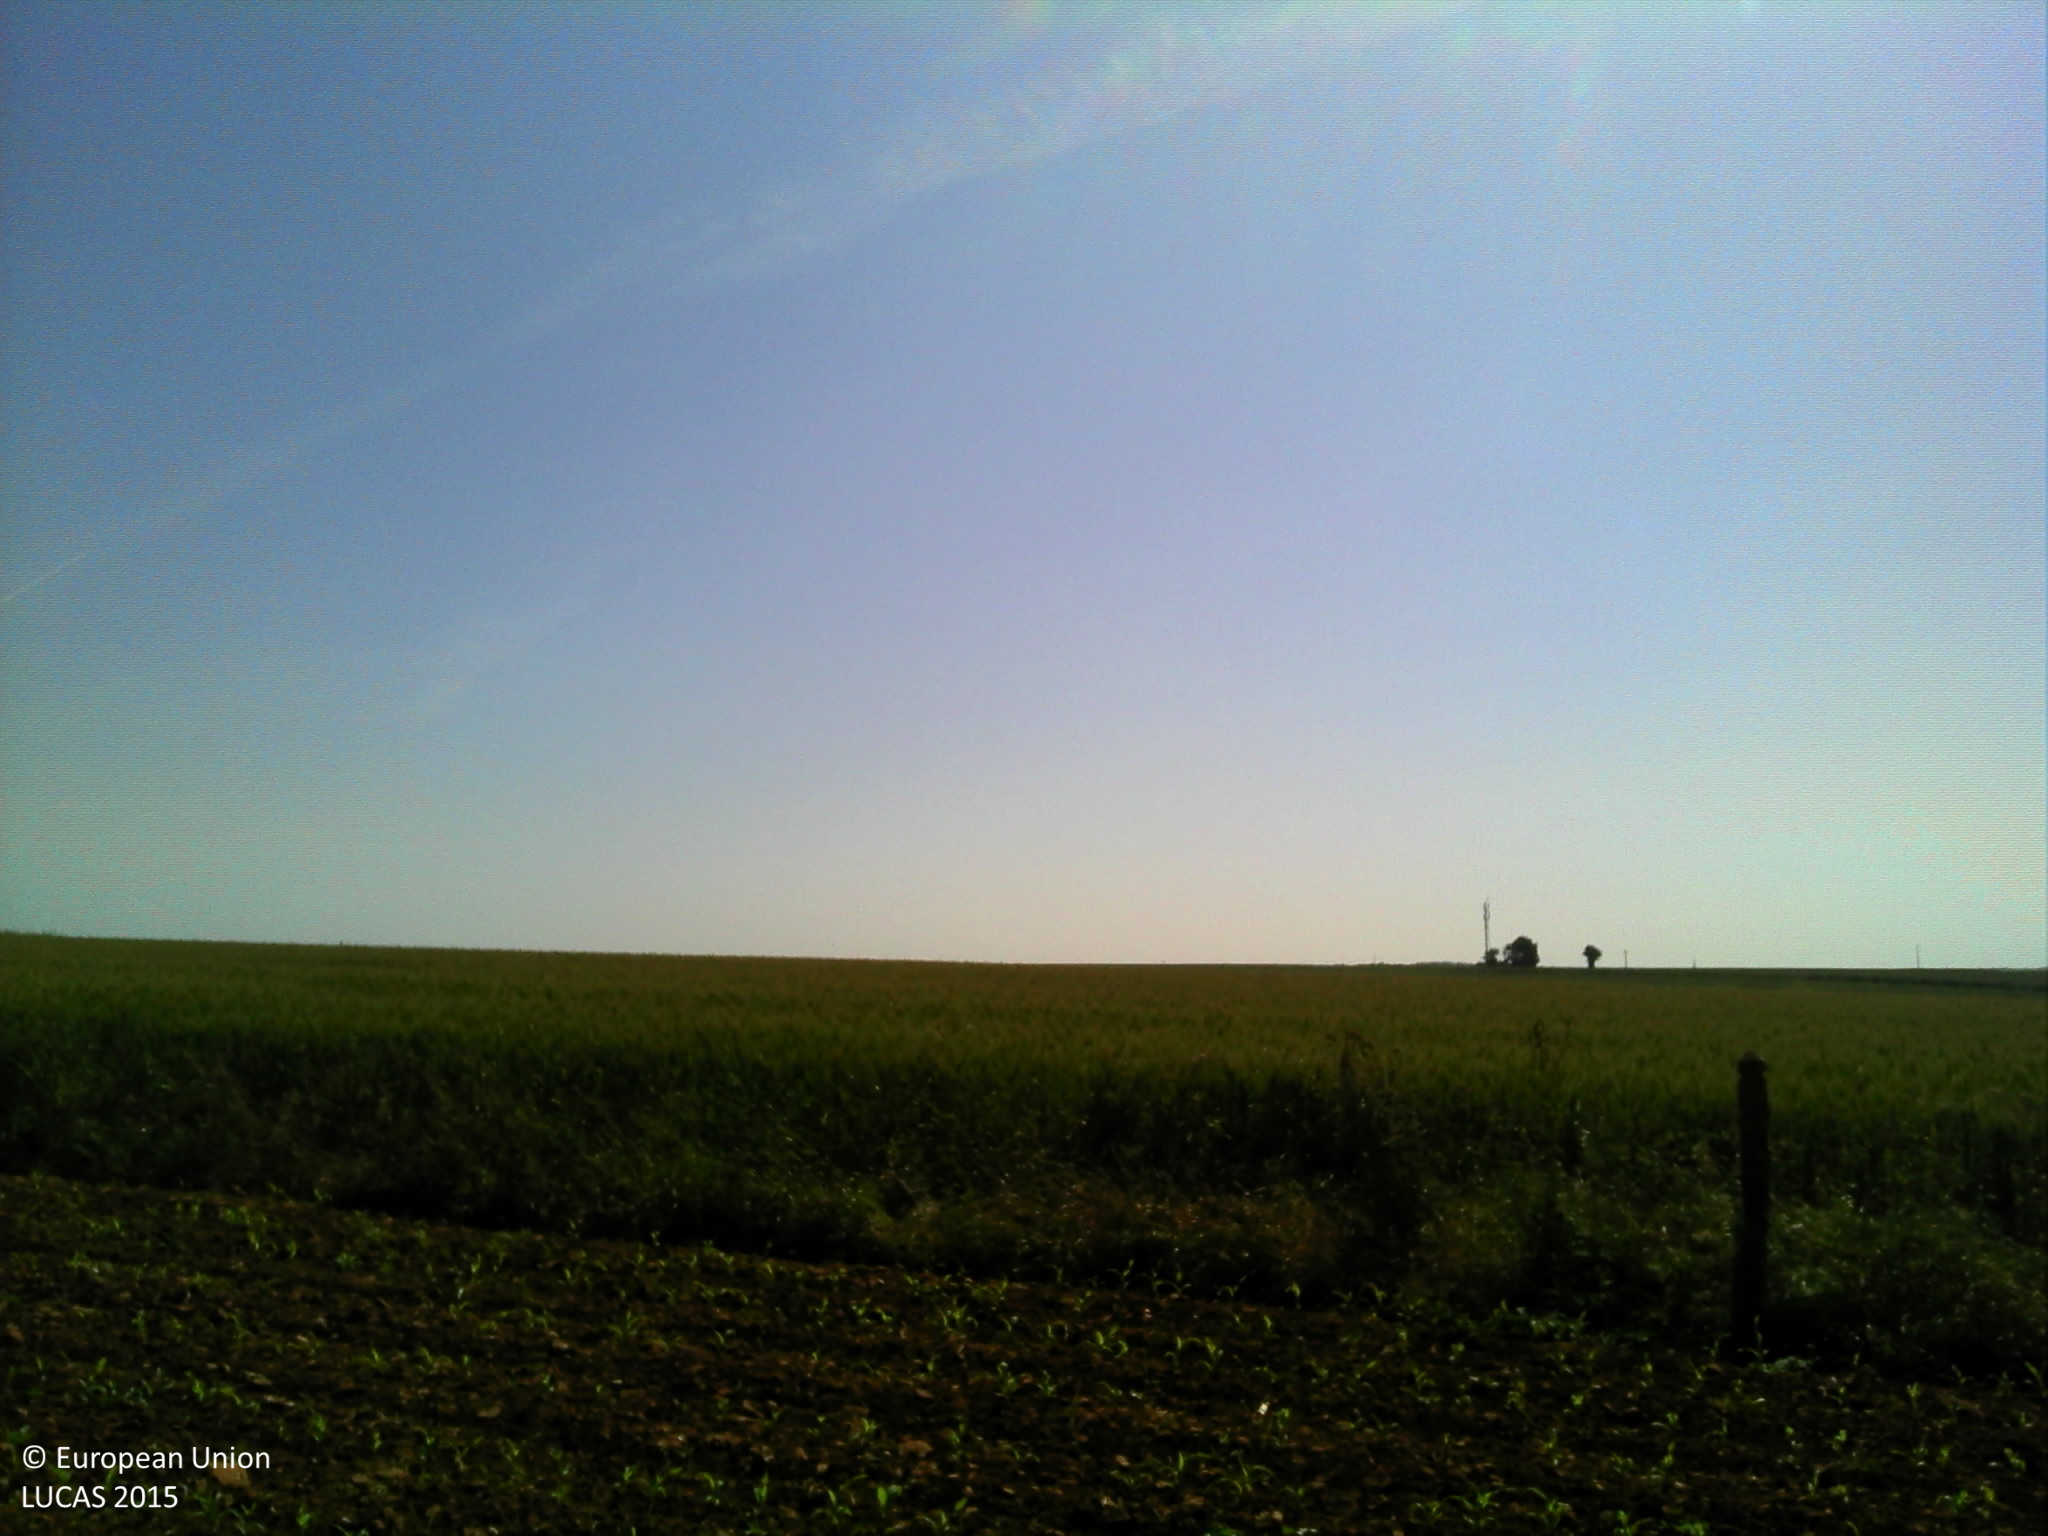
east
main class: Cropland
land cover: Maize
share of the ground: < 10 %
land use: Agriculture (excluding fallow land and kitchen gardens)
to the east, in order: Maize; Grass margins; Triticale; Grass margins; Rape and turnip rape; Triticale
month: June
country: FR
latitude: 48.1115
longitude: -0.0080
